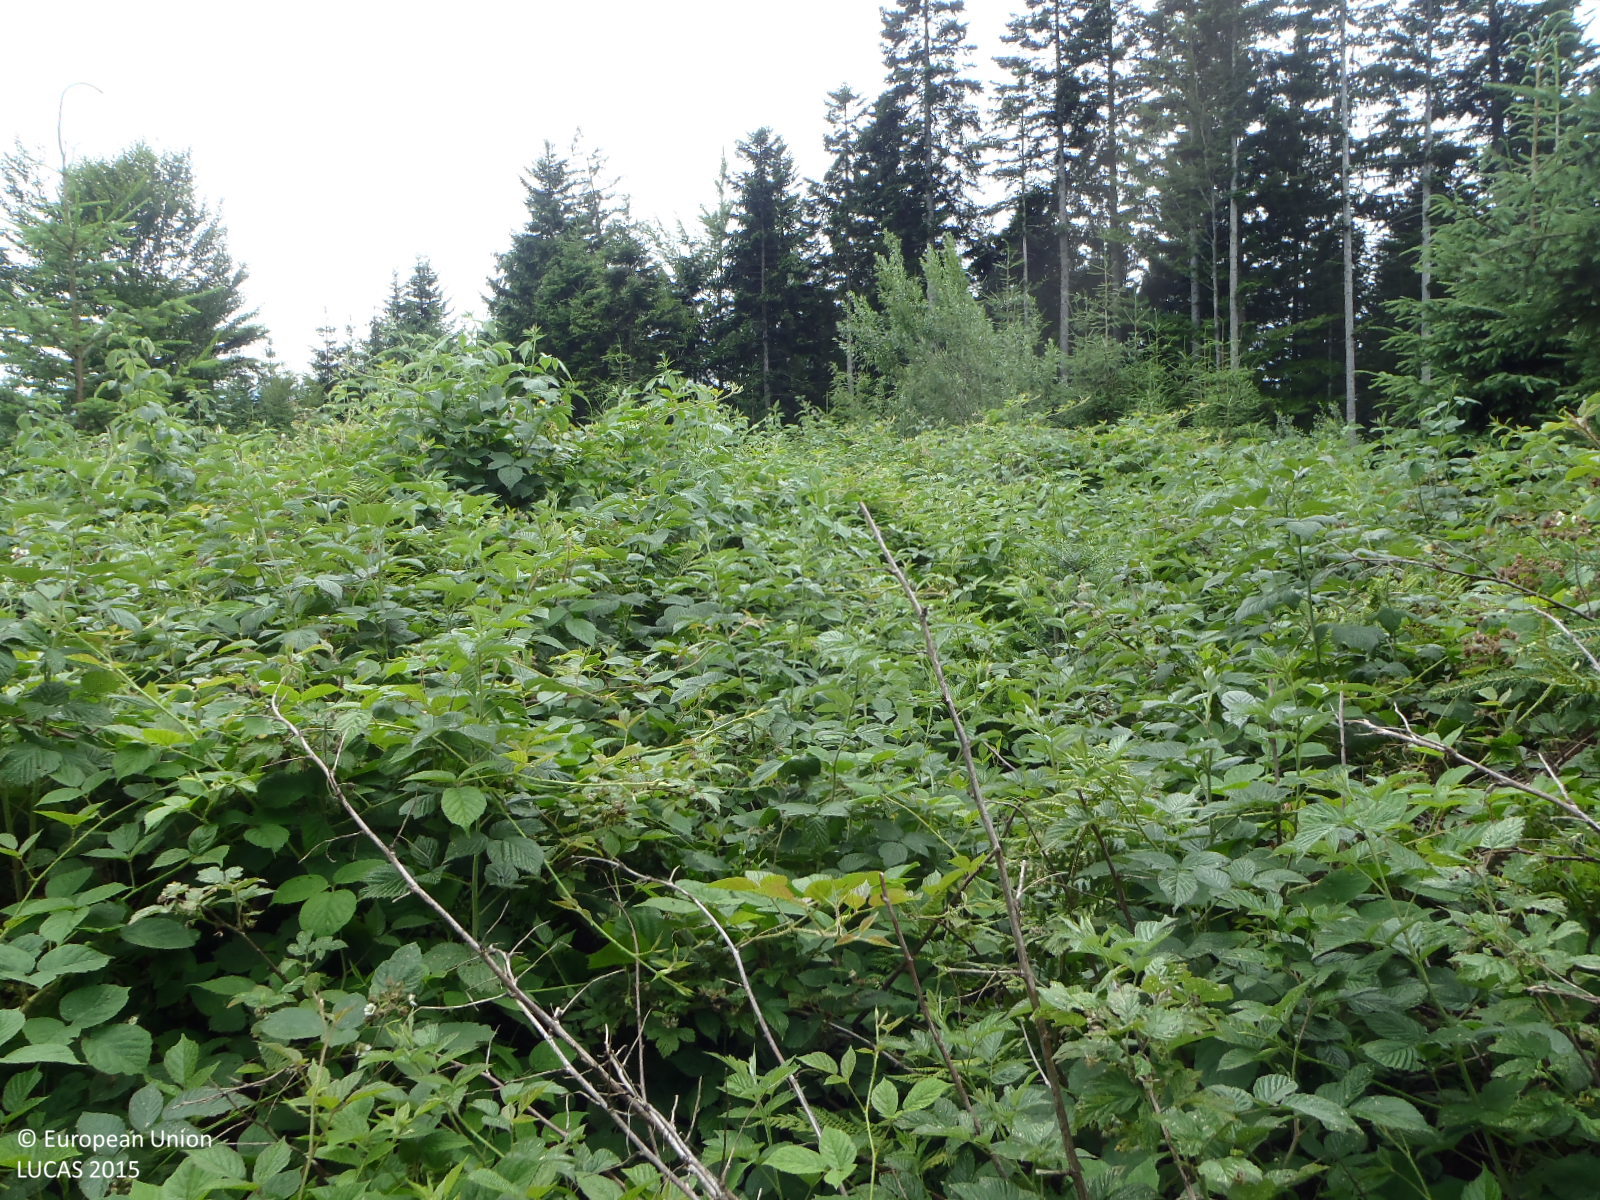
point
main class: Woodland
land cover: Other coniferous woodland
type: alpine coniferous forest
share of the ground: > 75 %
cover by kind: shrubs 55 %, coniferous forest trees 25 %, herbaceous plants 15 %, broadleaved forest trees 5 %
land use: Forestry
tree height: < 5 m
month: July
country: AT
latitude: 47.5312
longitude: 12.4026
